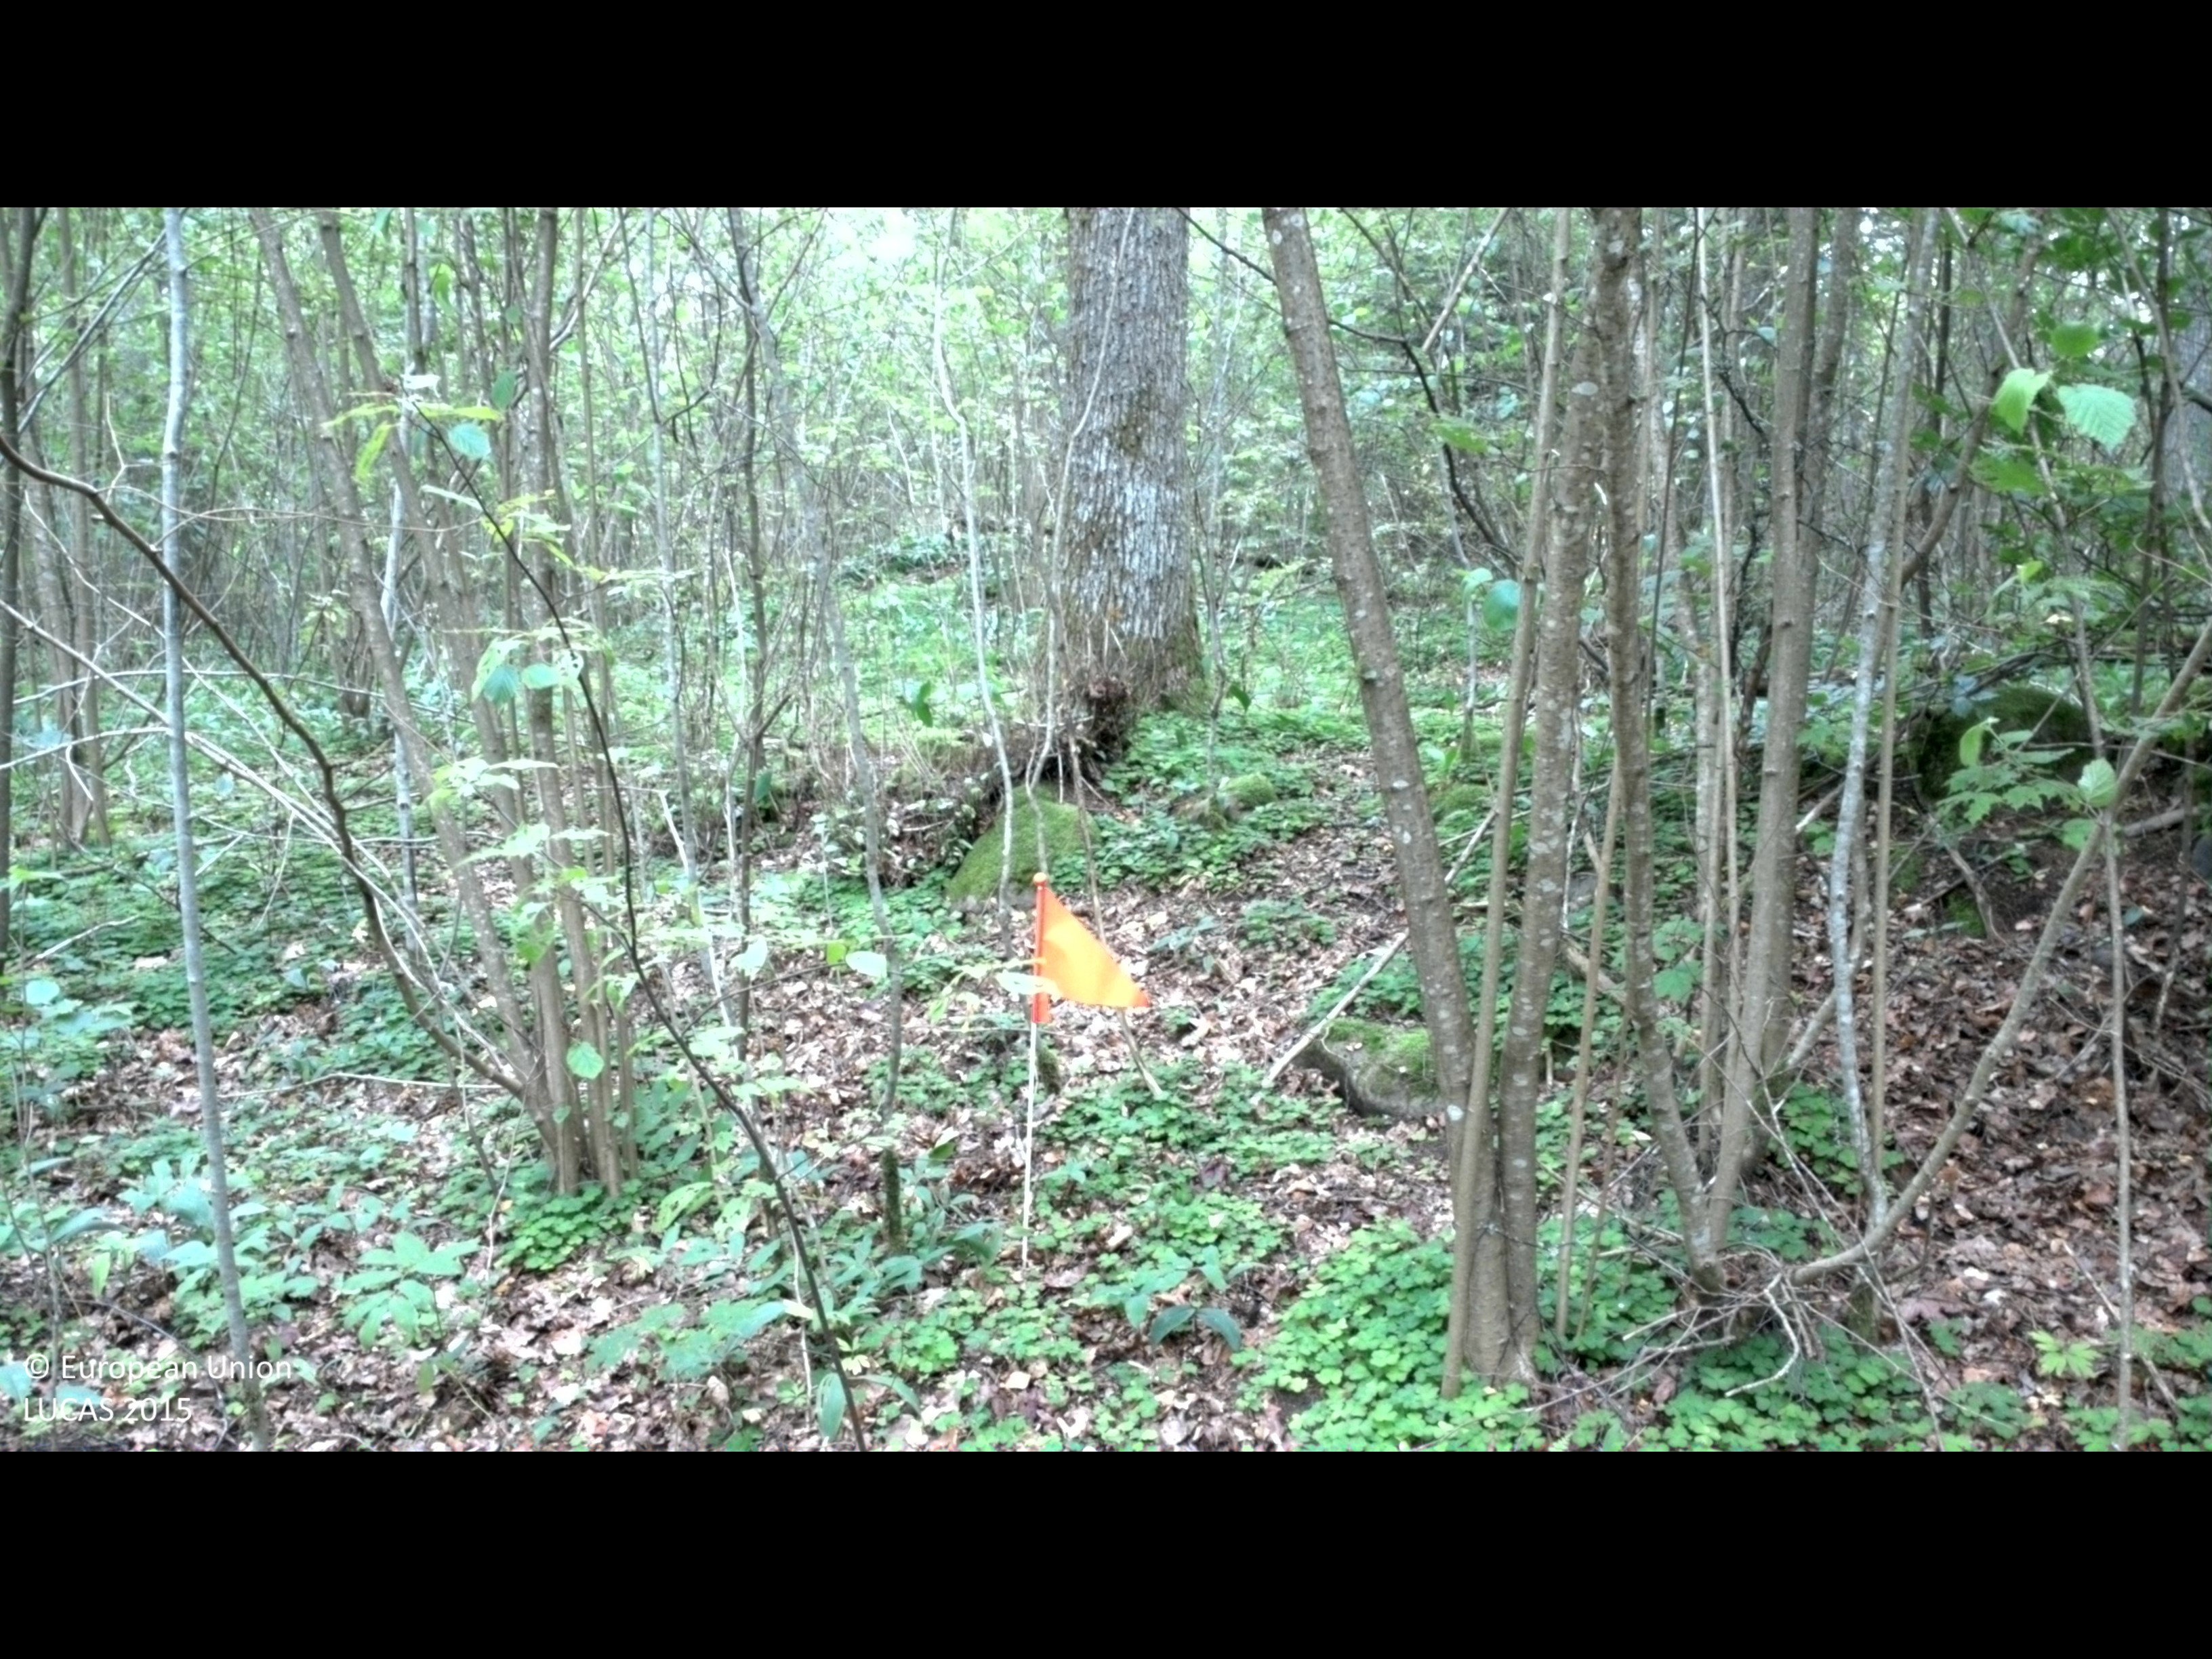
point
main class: Woodland
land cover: Broadleaved woodland
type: boreal forest
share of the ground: > 75 %
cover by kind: broadleaved forest trees 75 %, shrubs 20 %, herbaceous plants 5 %
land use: Forestry
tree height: > 5 m
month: July
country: SE
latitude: 56.8161
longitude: 13.7808
